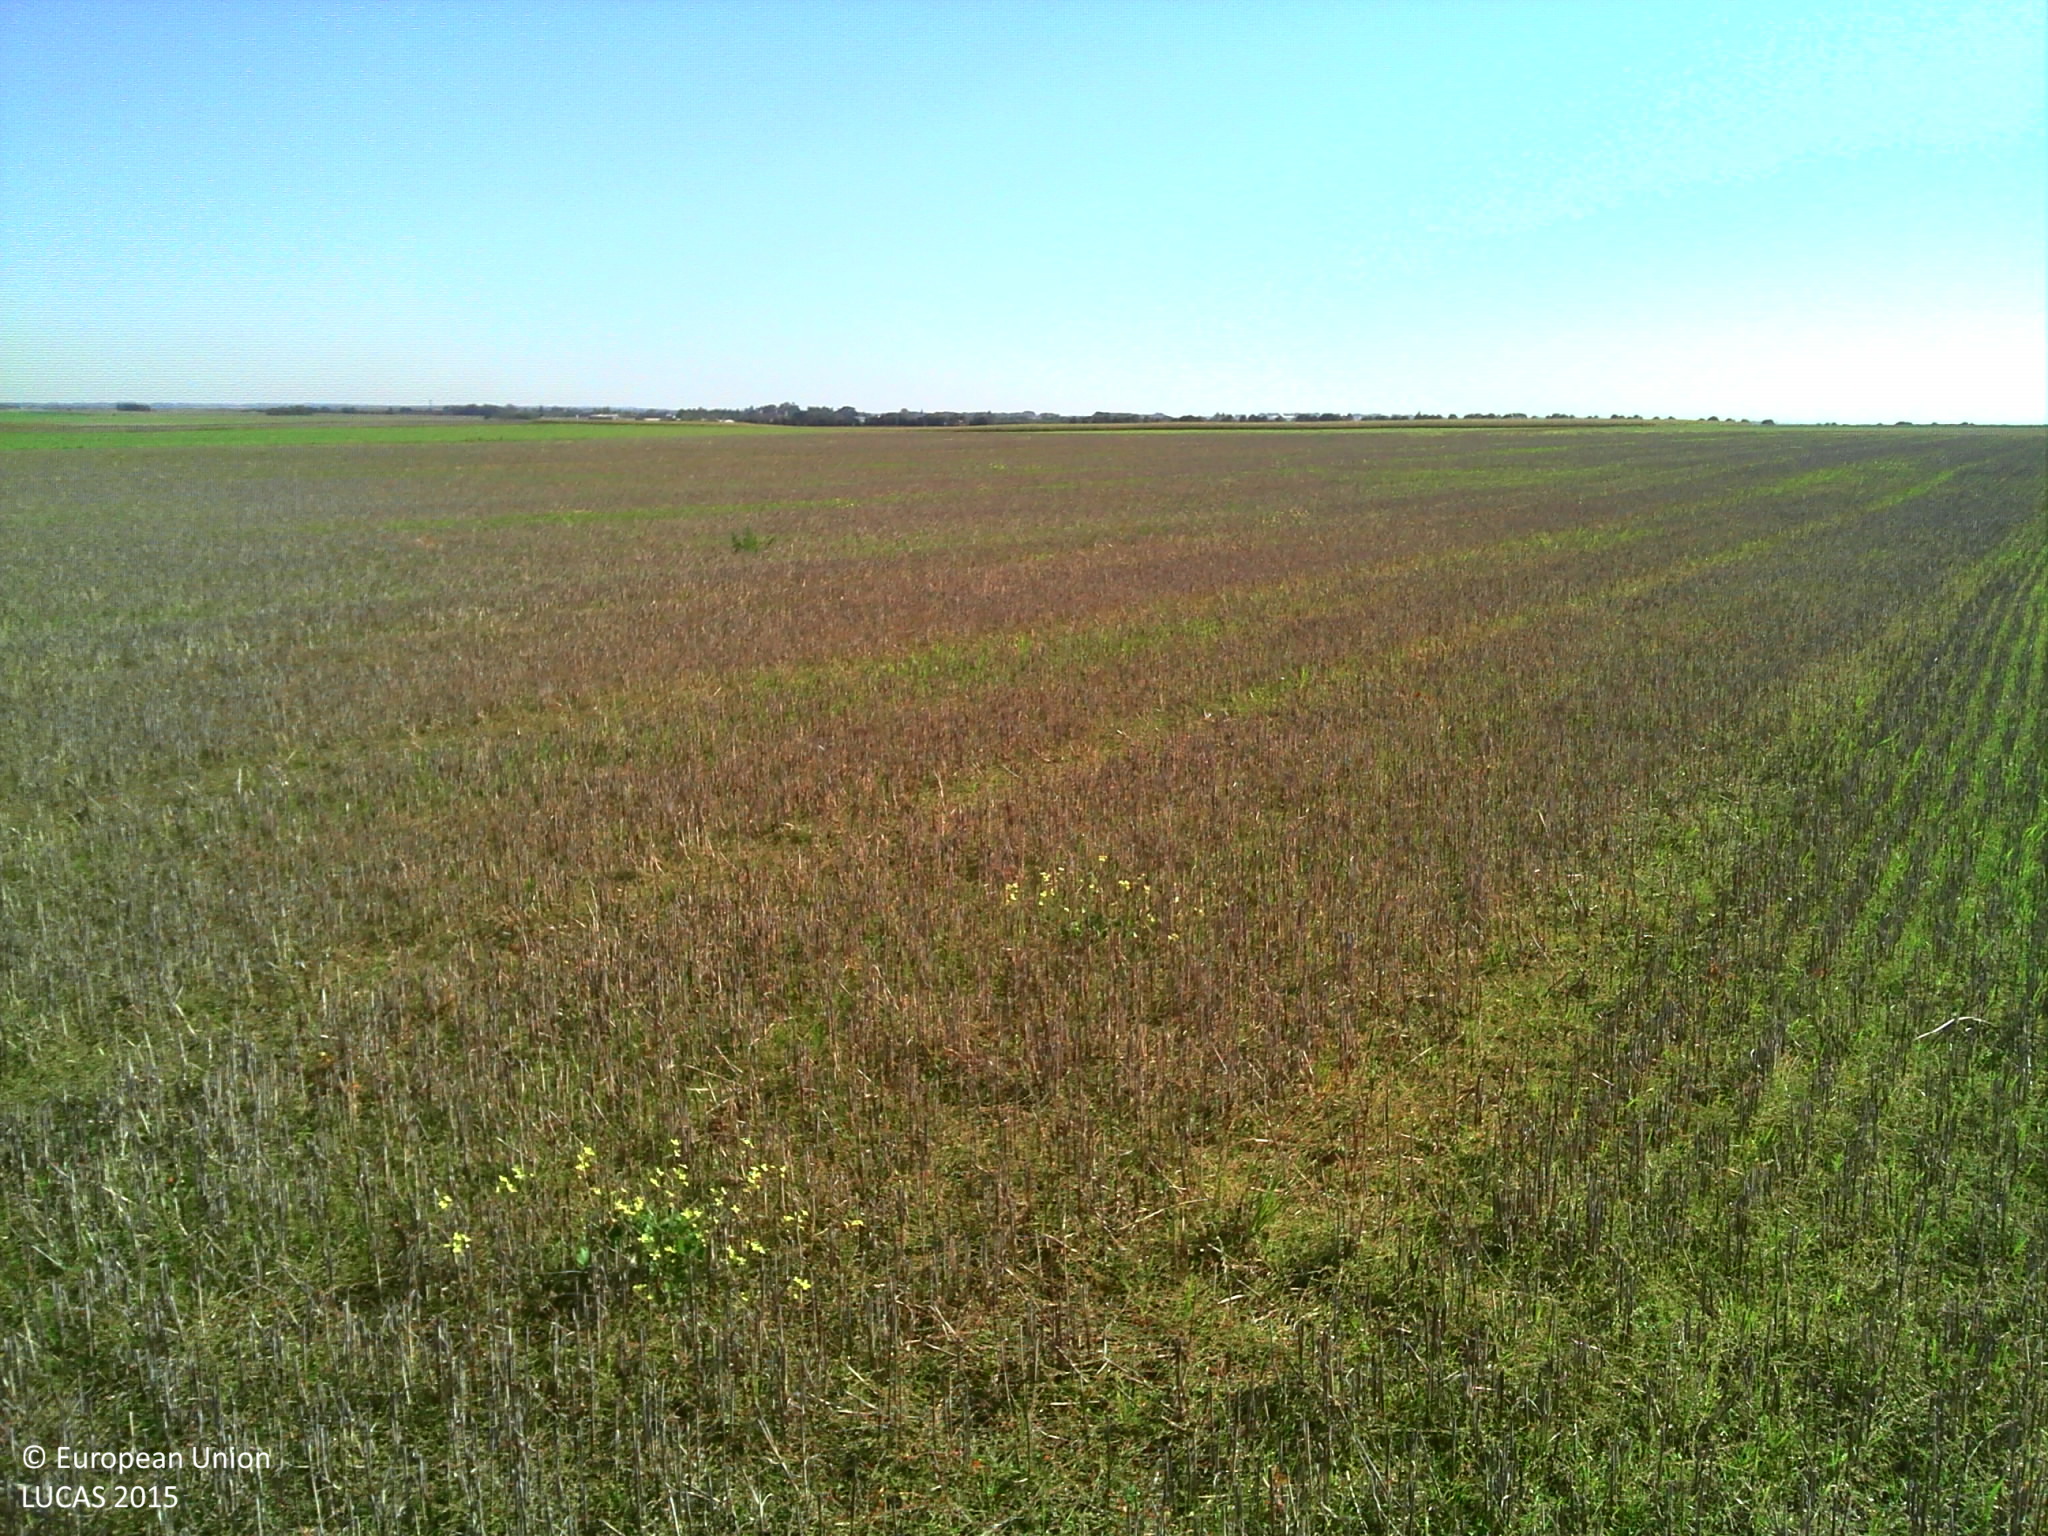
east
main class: Cropland
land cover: Common wheat
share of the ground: > 75 %
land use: Agriculture (excluding fallow land and kitchen gardens)
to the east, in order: Common wheat
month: September
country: FR
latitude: 46.5221
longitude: -1.0475
